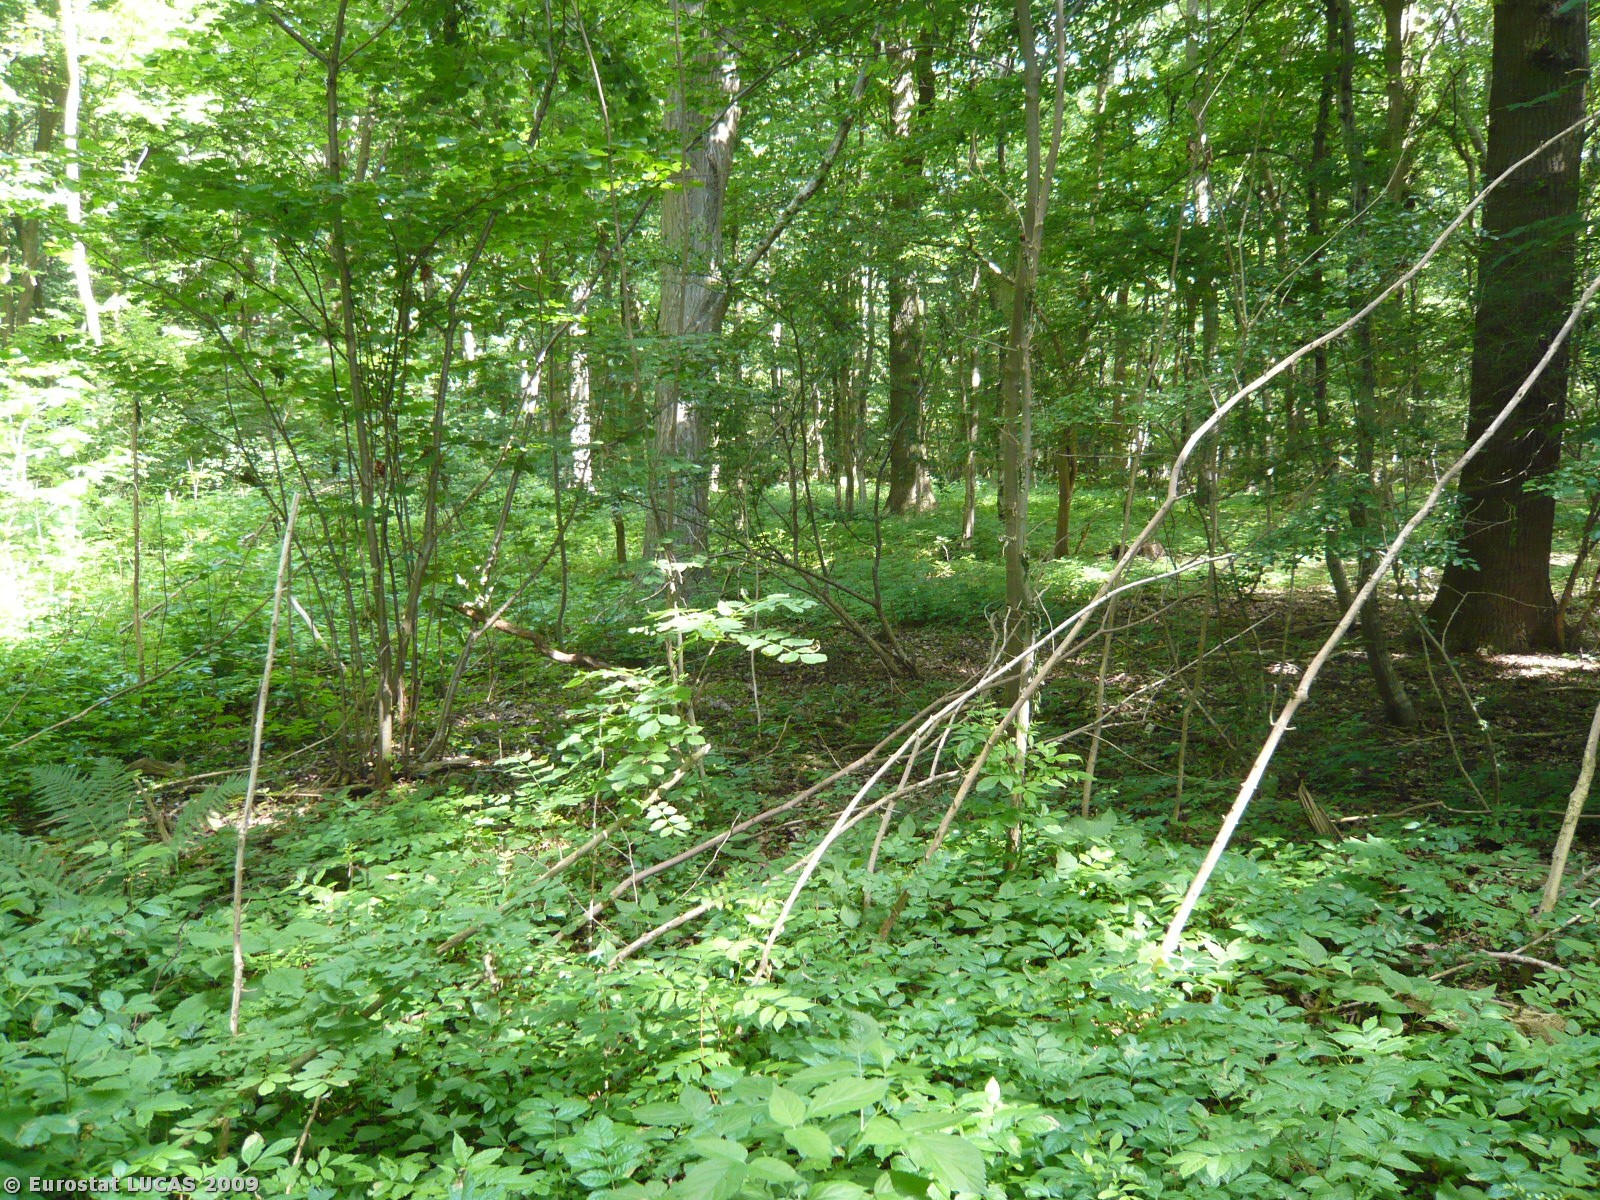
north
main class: Woodland
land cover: Broadleaved woodland
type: mesophytic deciduous forest
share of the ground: > 75 %
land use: Forestry
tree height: > 5 m
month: June
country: DK
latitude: 54.7200
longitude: 11.7222
